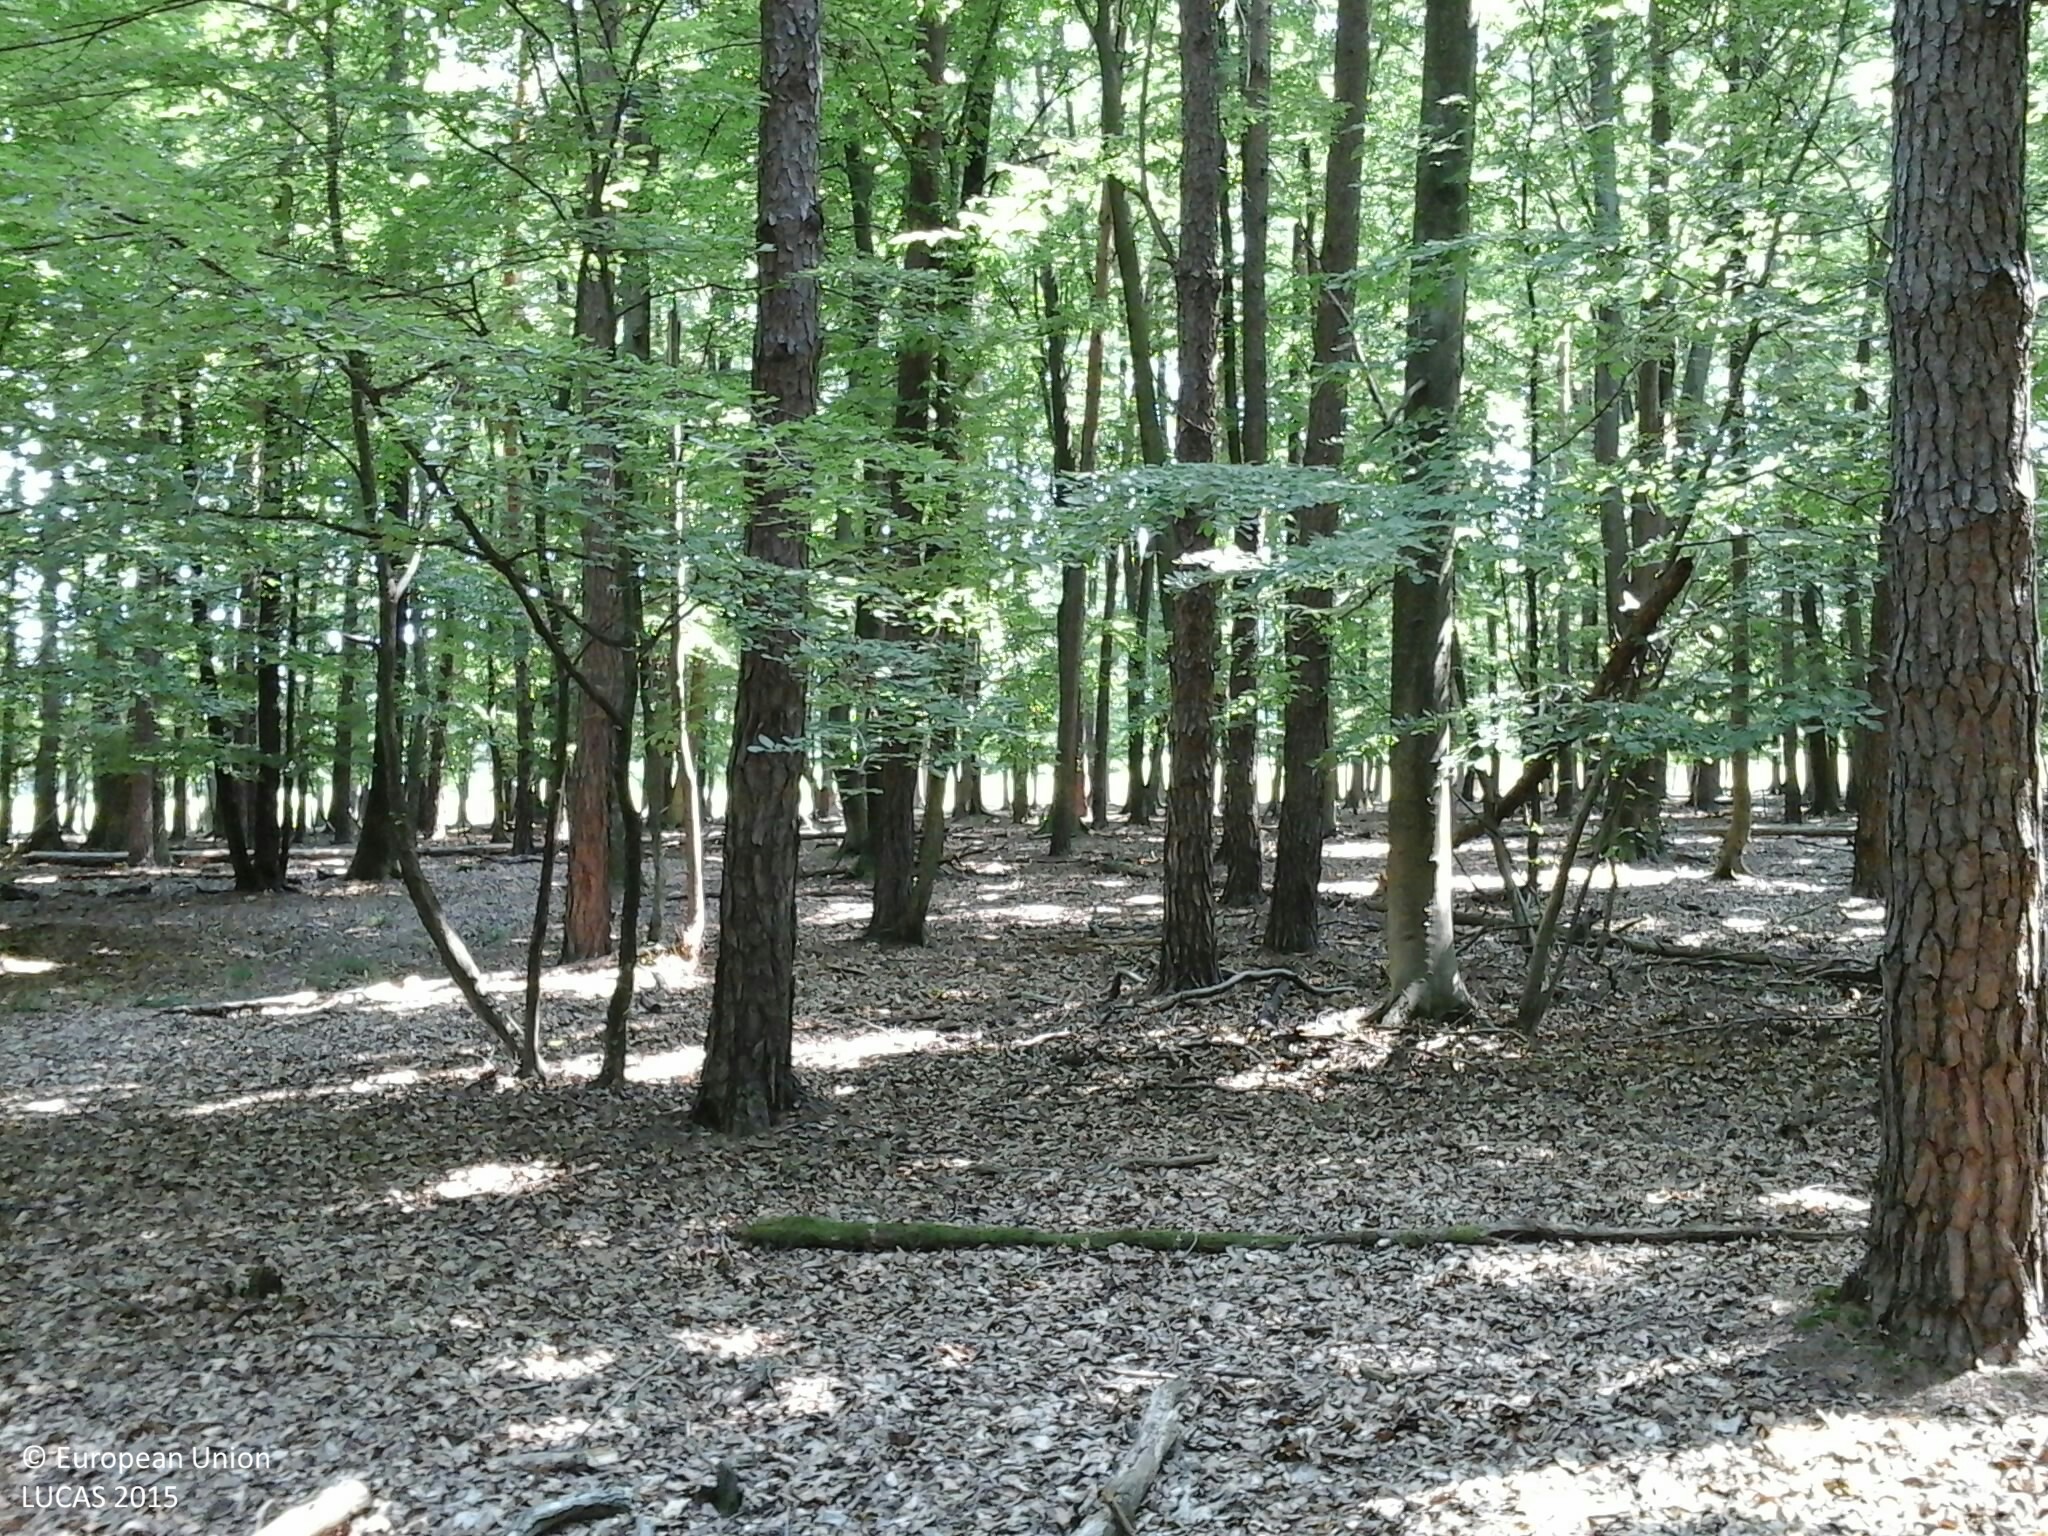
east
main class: Woodland
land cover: Broadleaved woodland
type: mesophytic deciduous forest
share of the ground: > 75 %
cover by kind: broadleaved forest trees 90 %, coniferous forest trees 10 %
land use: Forestry
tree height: > 5 m
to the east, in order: Broadleaved woodland; Grass margins; Fences; Broadleaved woodland; Fences; Grass margins; Tracks; Broadleaved woodland
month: July
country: HU
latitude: 46.6711
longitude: 16.6029
